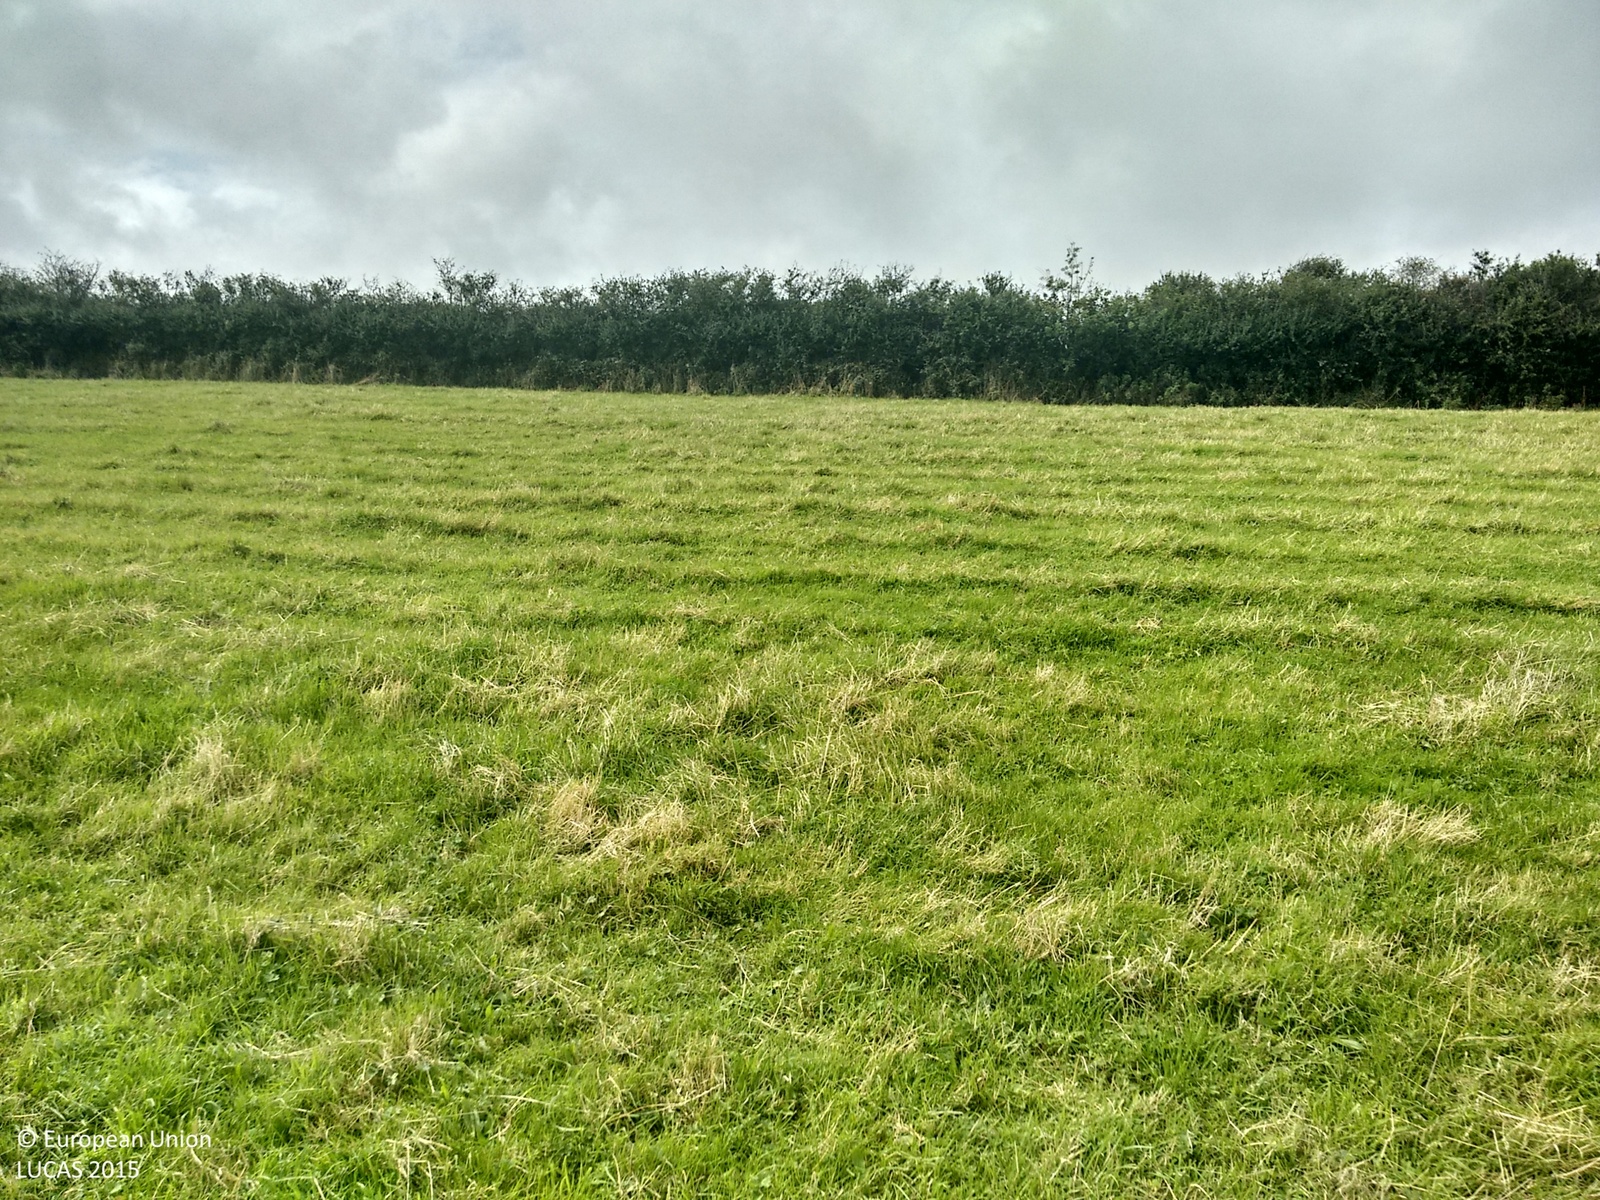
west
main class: Grassland
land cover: Grassland without tree/shrub cover
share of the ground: > 75 %
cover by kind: herbaceous plants 100 %
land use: Agriculture (excluding fallow land and kitchen gardens)
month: August
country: GB
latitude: 50.0452
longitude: -5.1298
